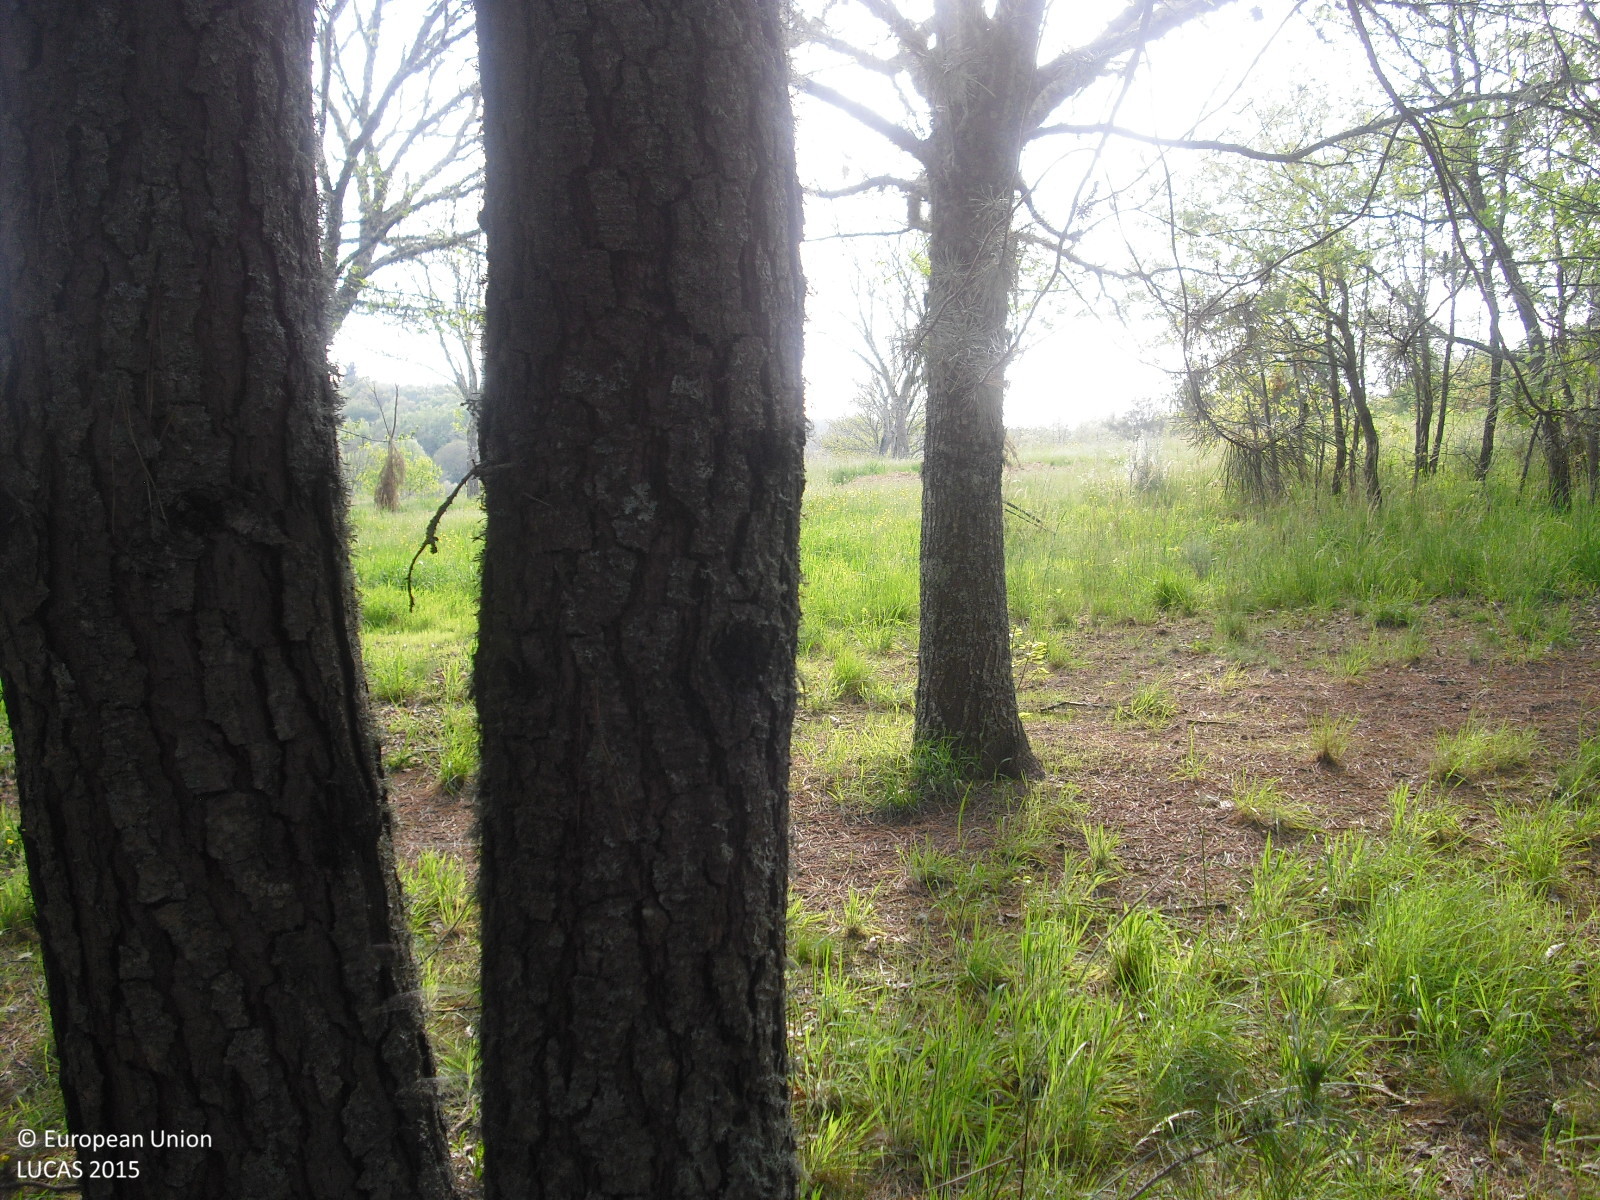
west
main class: Woodland
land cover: Pine dominated coniferous woodland
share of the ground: > 75 %
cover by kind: coniferous forest trees 100 %
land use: Forestry
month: May
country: ES
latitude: 41.9455
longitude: -7.2936
